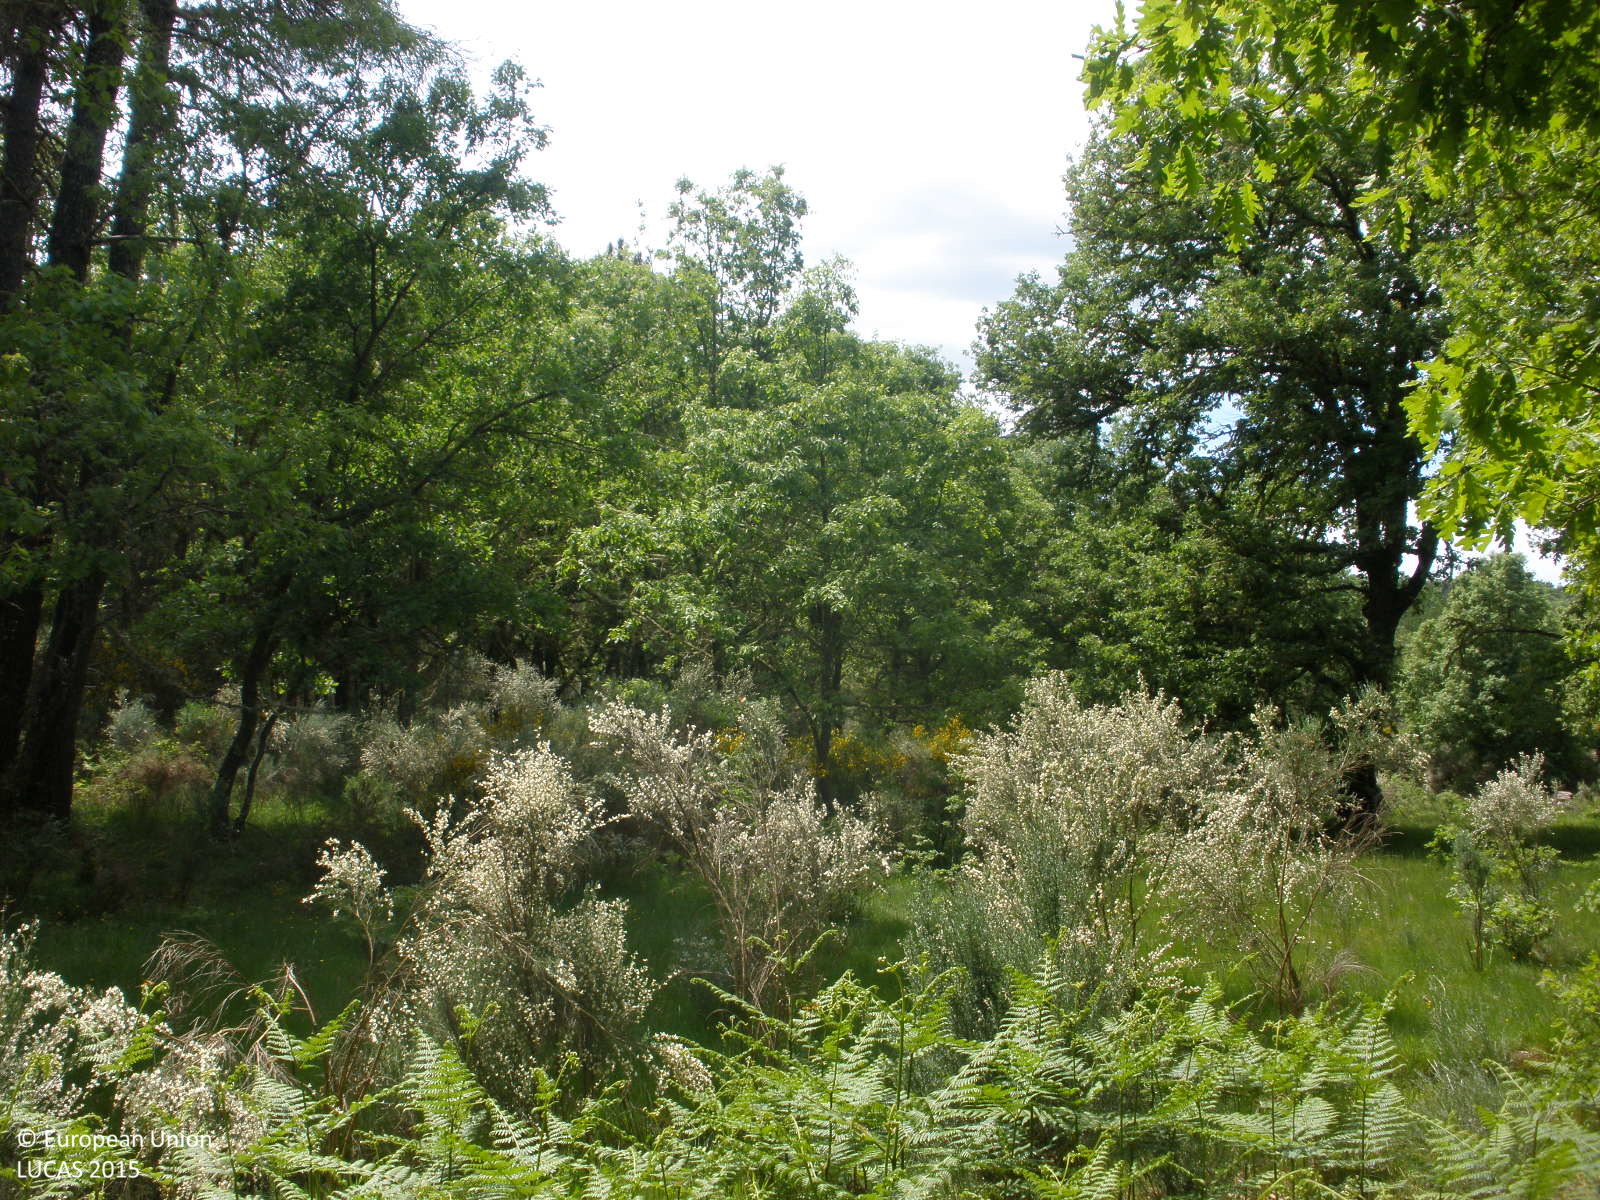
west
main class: Woodland
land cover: Broadleaved woodland
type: thermophilous deciduous forest
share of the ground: > 75 %
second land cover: Grassland without tree/shrub cover
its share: > 75 %
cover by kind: broadleaved forest trees 80 %, shrubs 10 %, herbaceous plants 10 %
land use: Forestry
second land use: Agriculture (excluding fallow land and kitchen gardens)
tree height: > 5 m
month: May
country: ES
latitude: 40.3084
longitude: -6.6429
